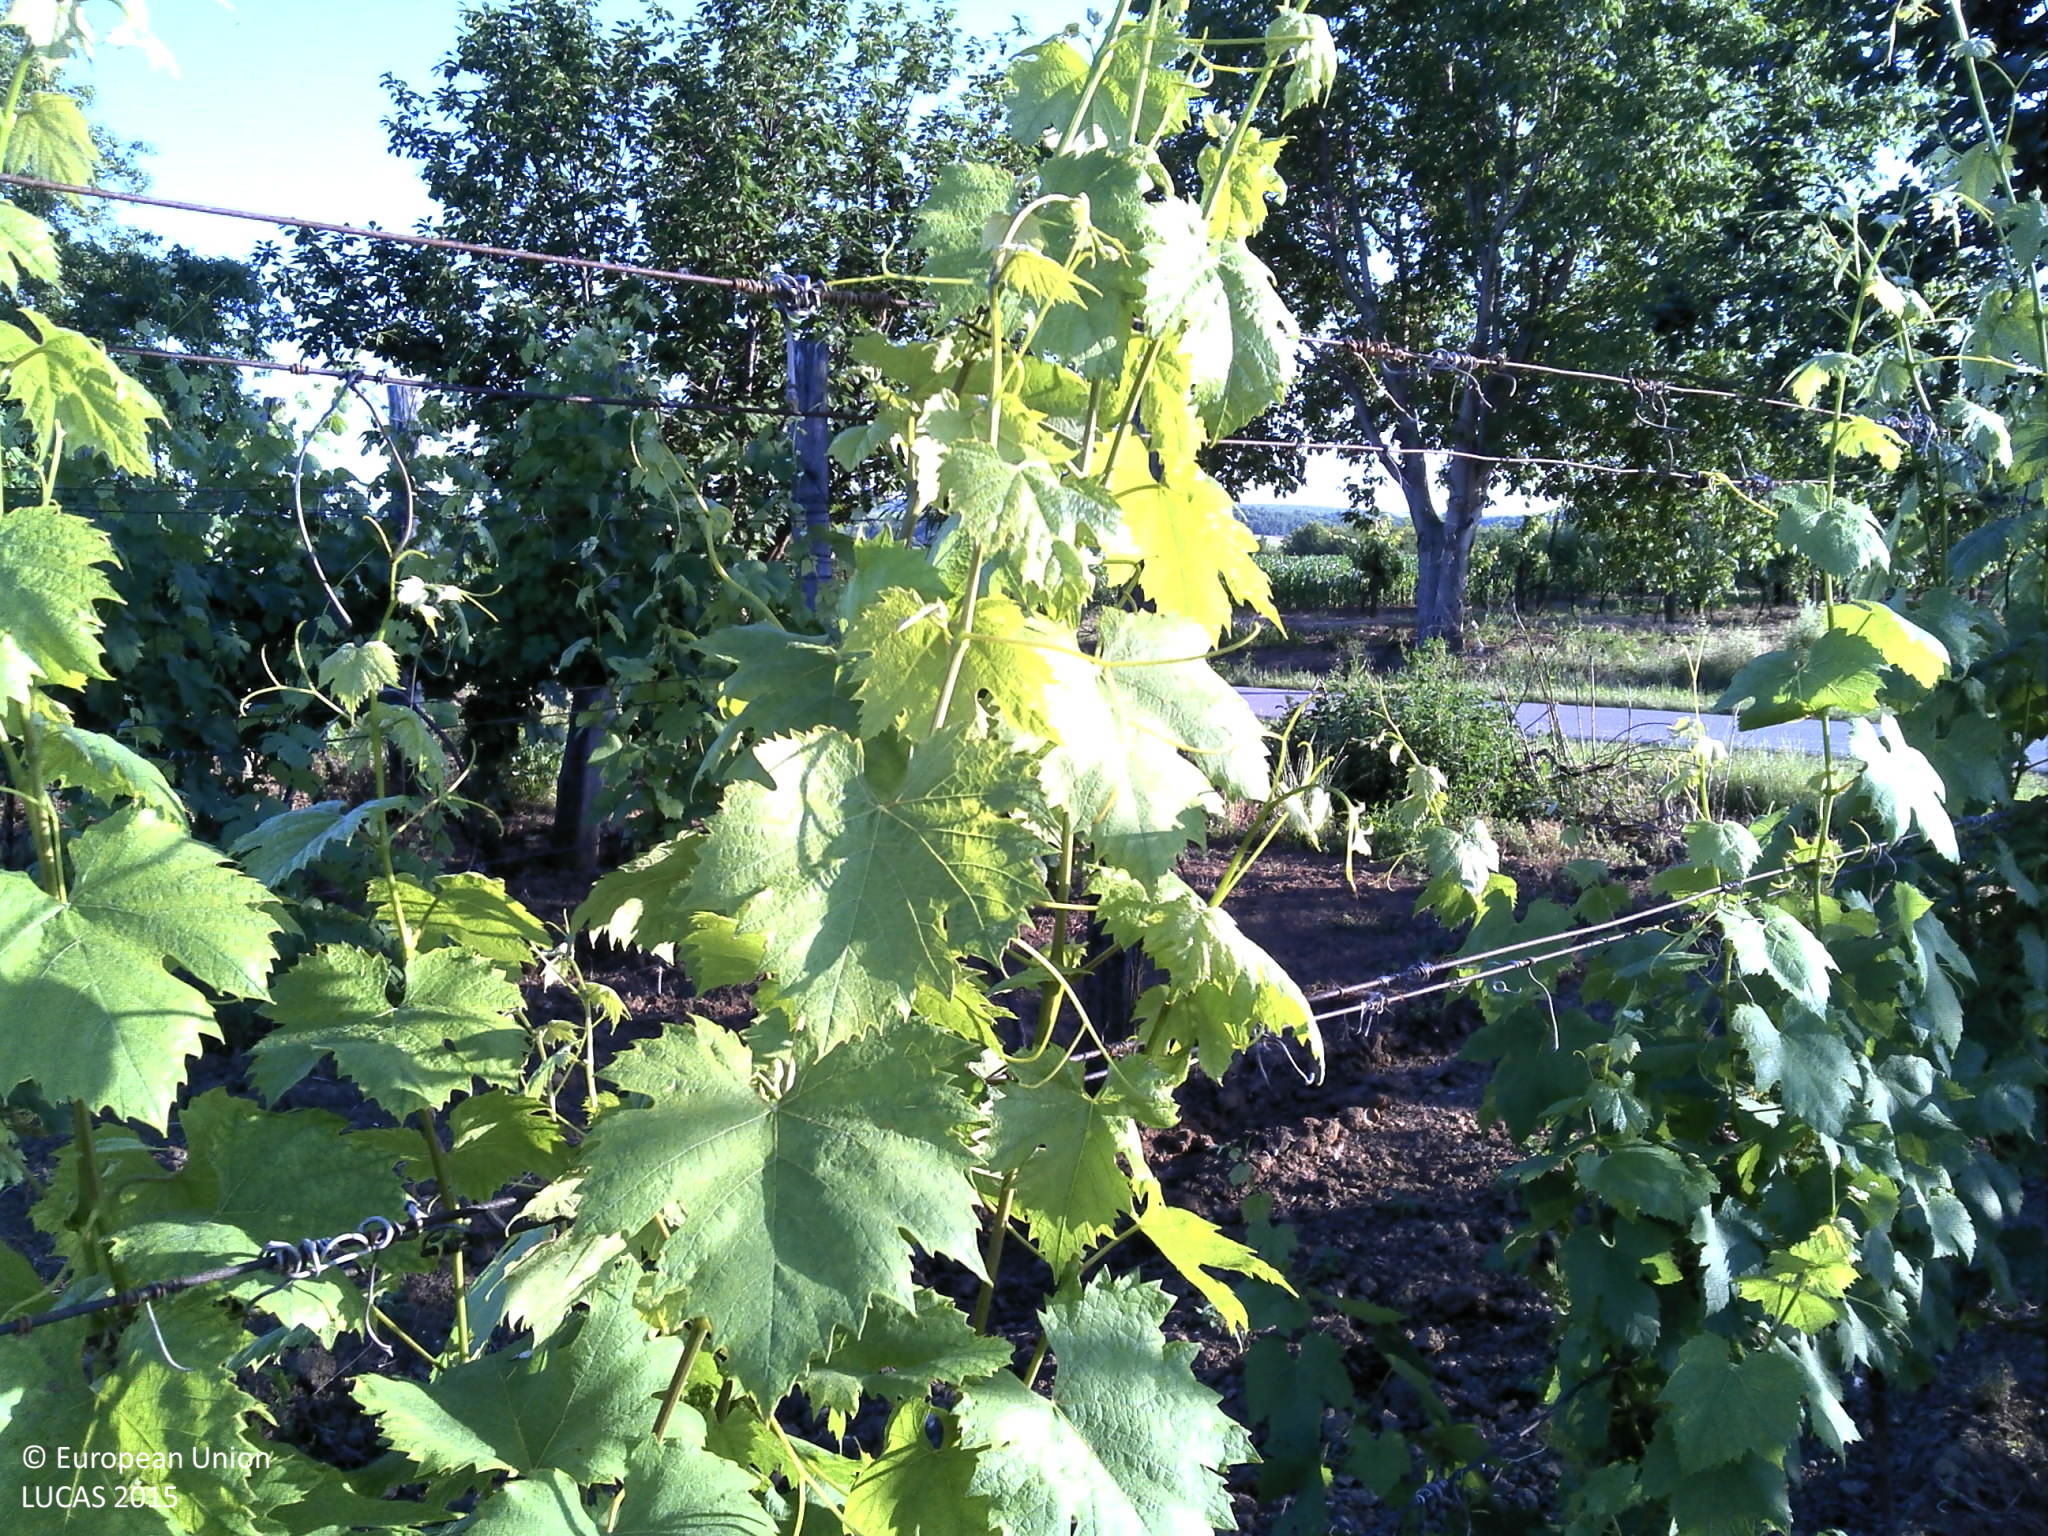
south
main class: Cropland
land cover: Vineyards
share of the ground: 10 - 25 %
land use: Agriculture (excluding fallow land and kitchen gardens)
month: June
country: HR
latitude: 45.2093
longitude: 19.4201
